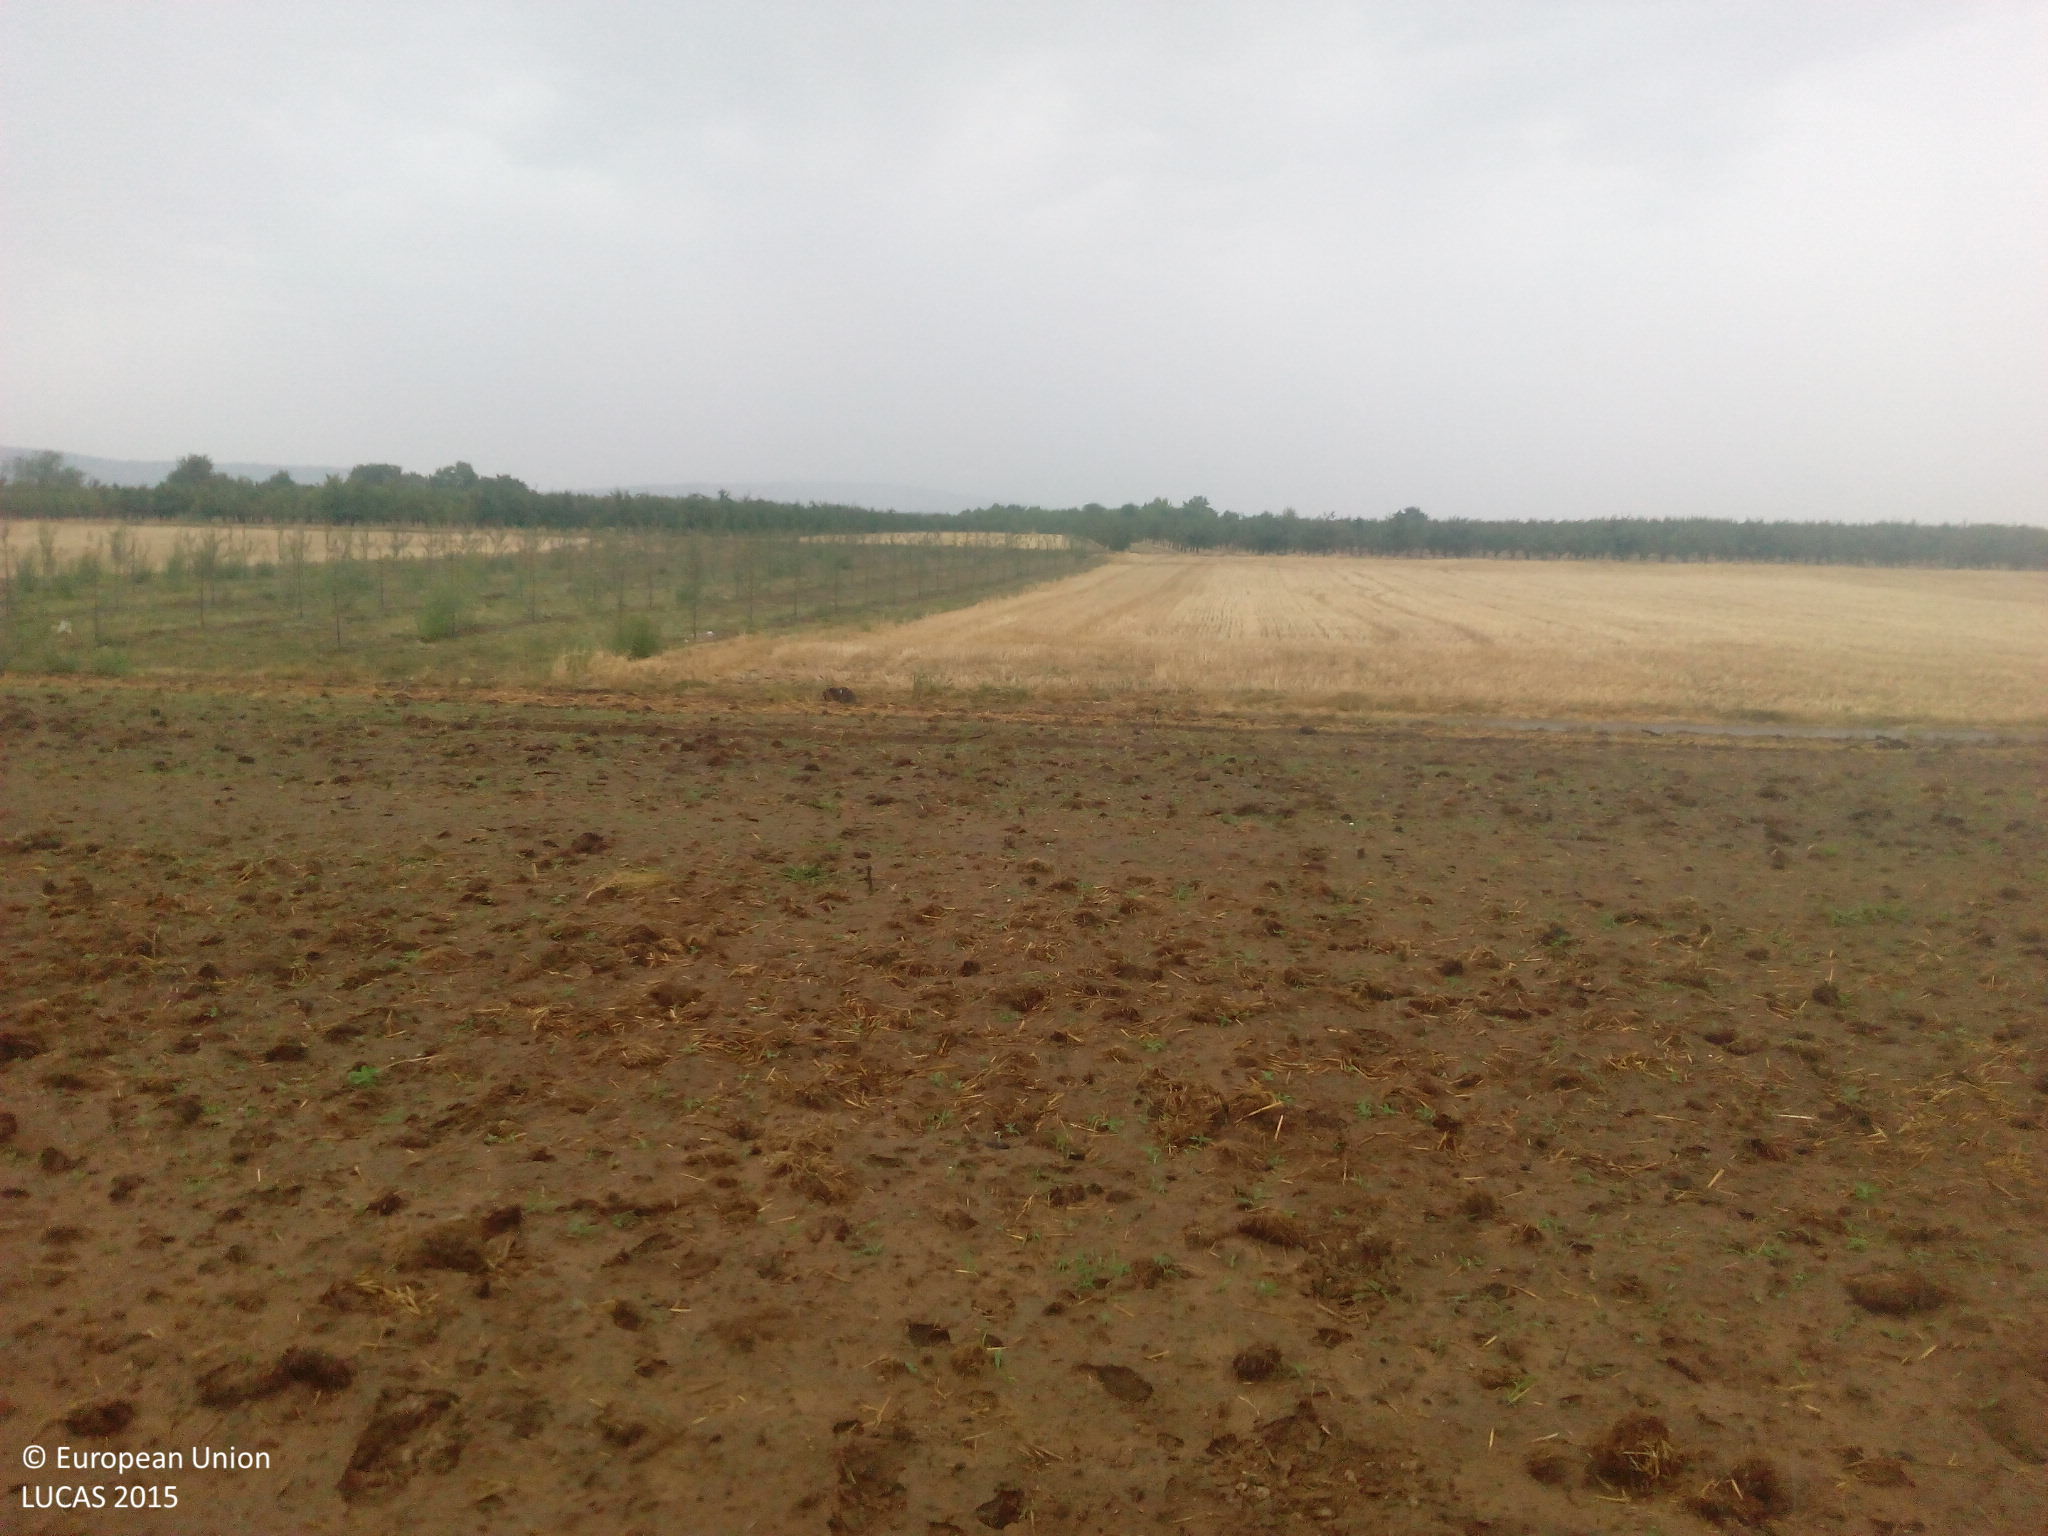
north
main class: Cropland
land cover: Common wheat
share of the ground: < 10 %
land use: Agriculture (excluding fallow land and kitchen gardens)
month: August
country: DE
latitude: 49.9893
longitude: 8.1453
